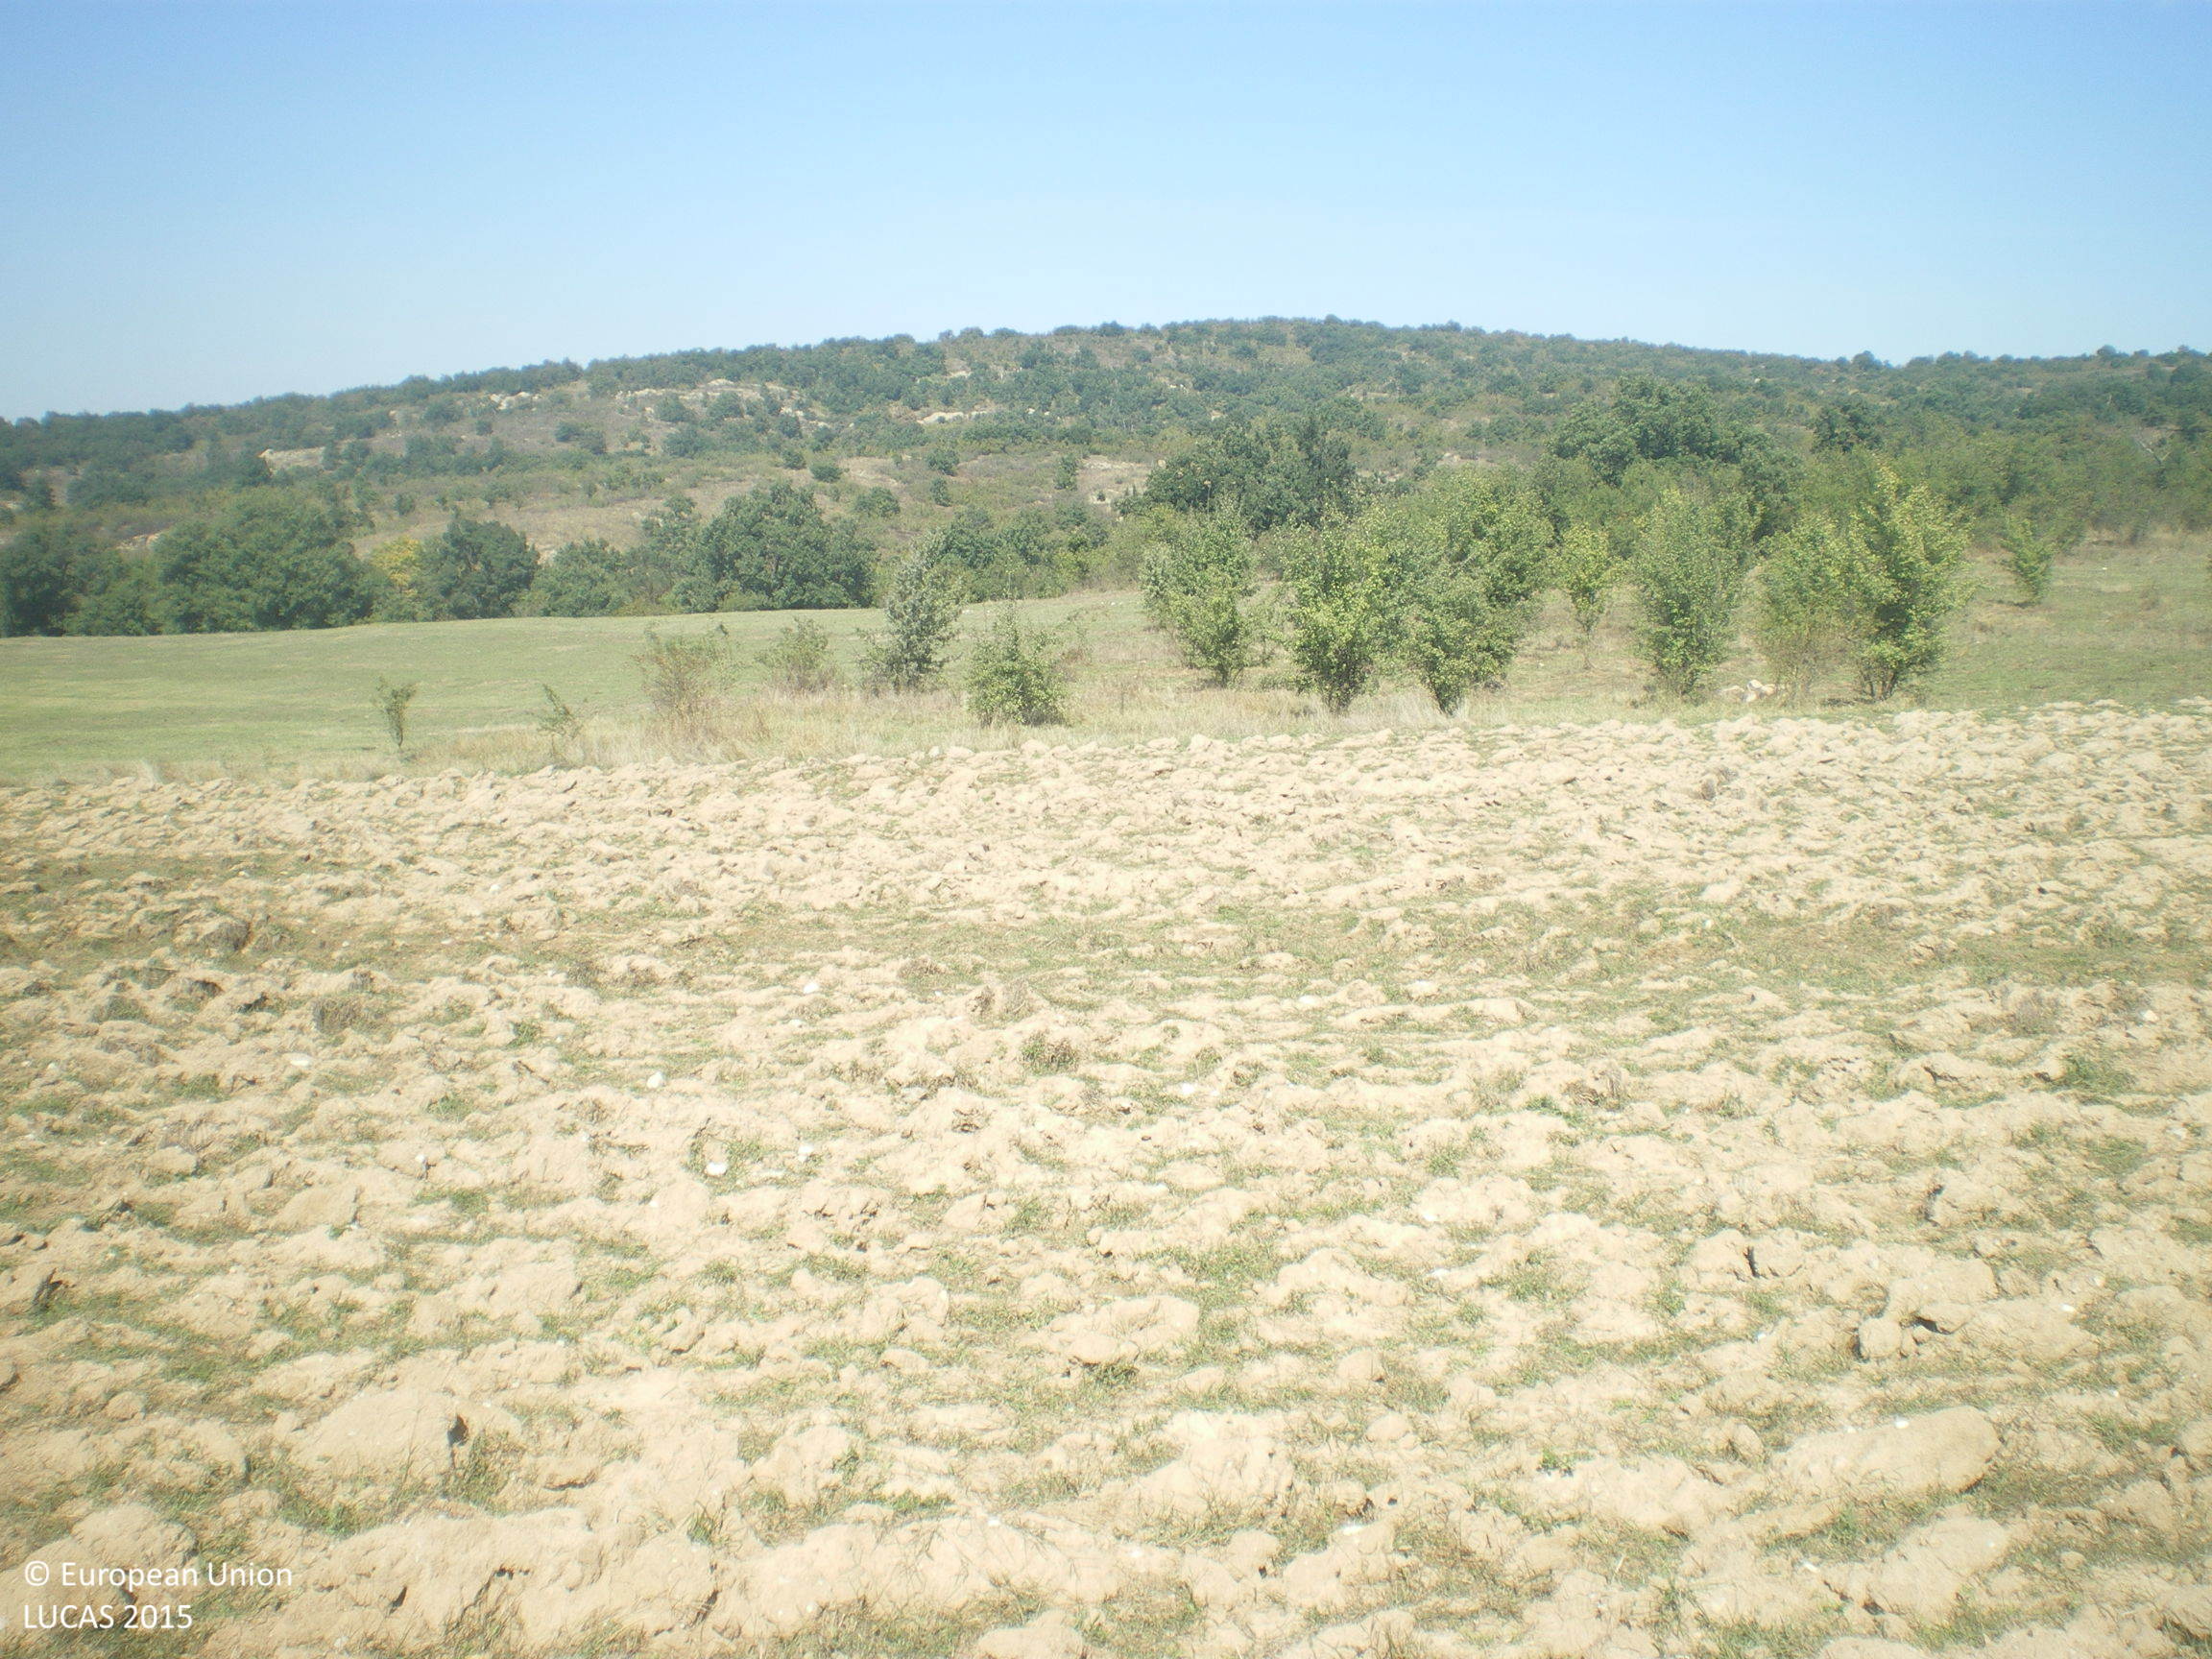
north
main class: Grassland
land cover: Spontaneously vegetated surfaces
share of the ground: 25 - 50 %
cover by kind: herbaceous plants 80 %, consolidated bare surface 20 %
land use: Agriculture (excluding fallow land and kitchen gardens)
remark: Harvested field
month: September
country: BG
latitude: 41.8944
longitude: 25.7239
